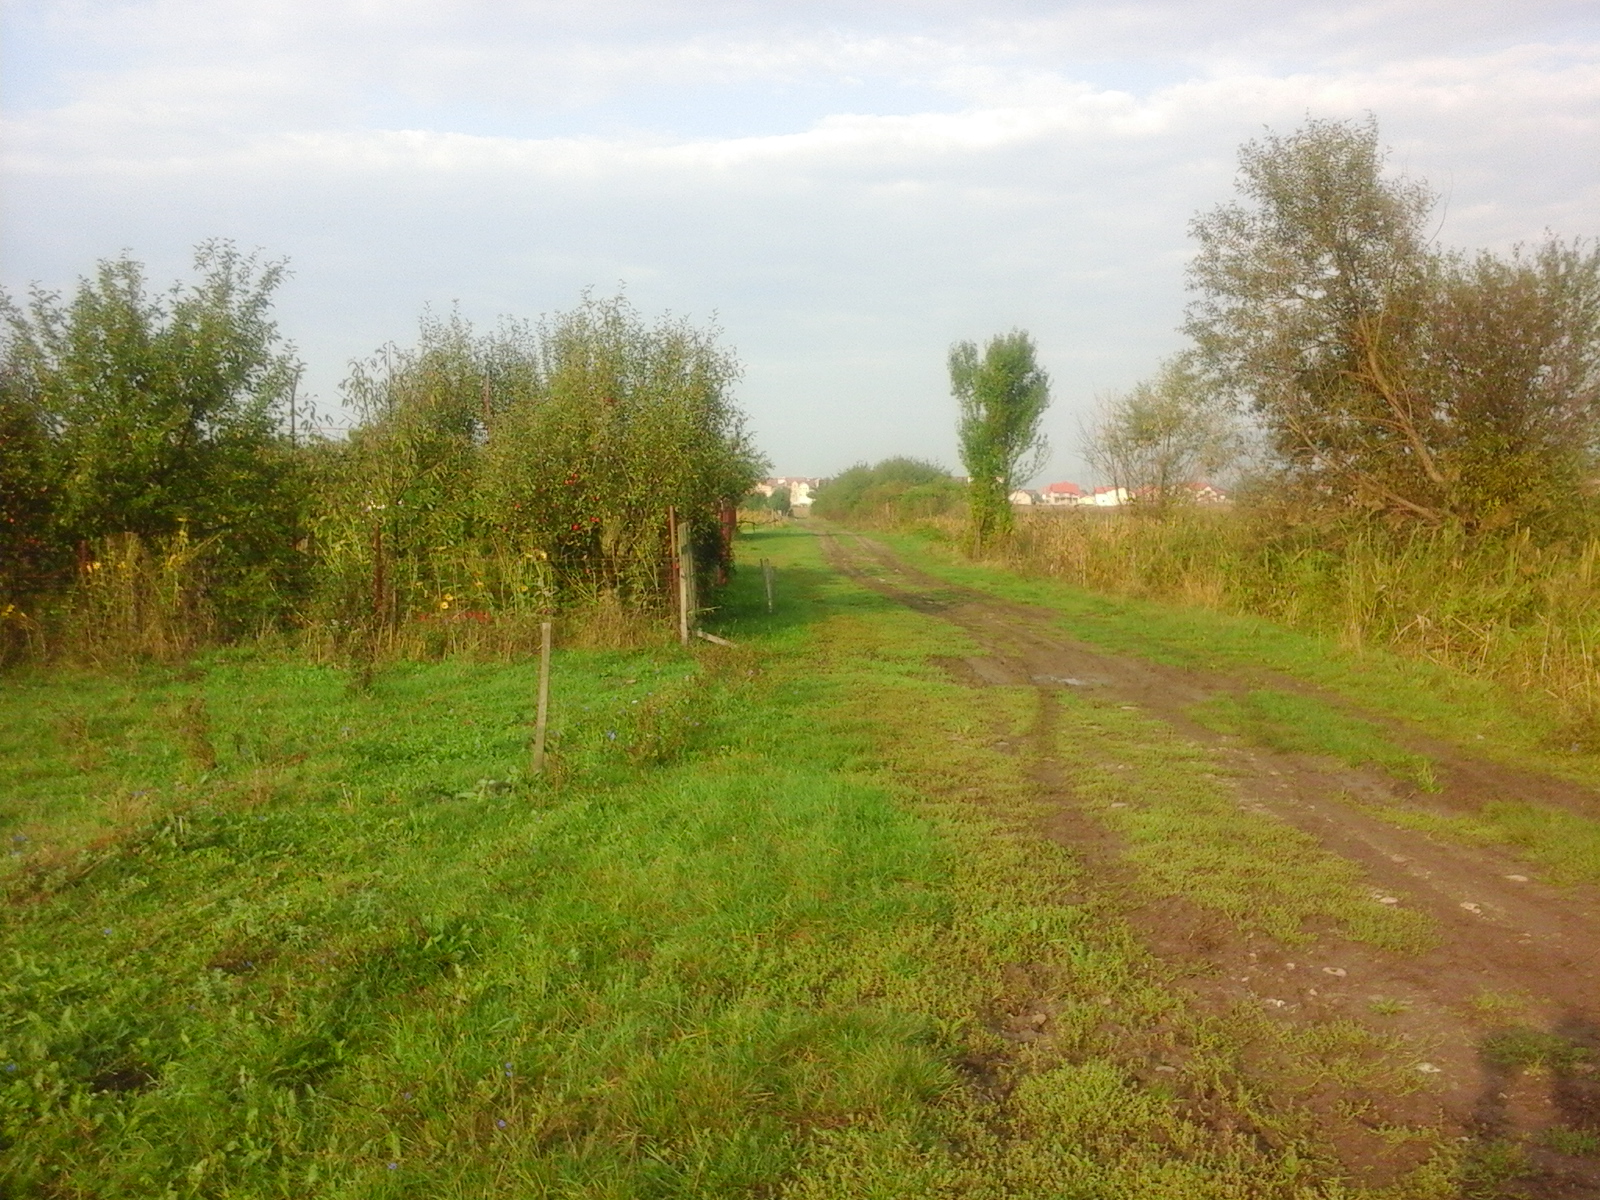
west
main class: Grassland
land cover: Spontaneously vegetated surfaces
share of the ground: > 75 %
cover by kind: herbaceous plants 100 %
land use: Agriculture (excluding fallow land and kitchen gardens)
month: September
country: RO
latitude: 45.6128
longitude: 22.9661
